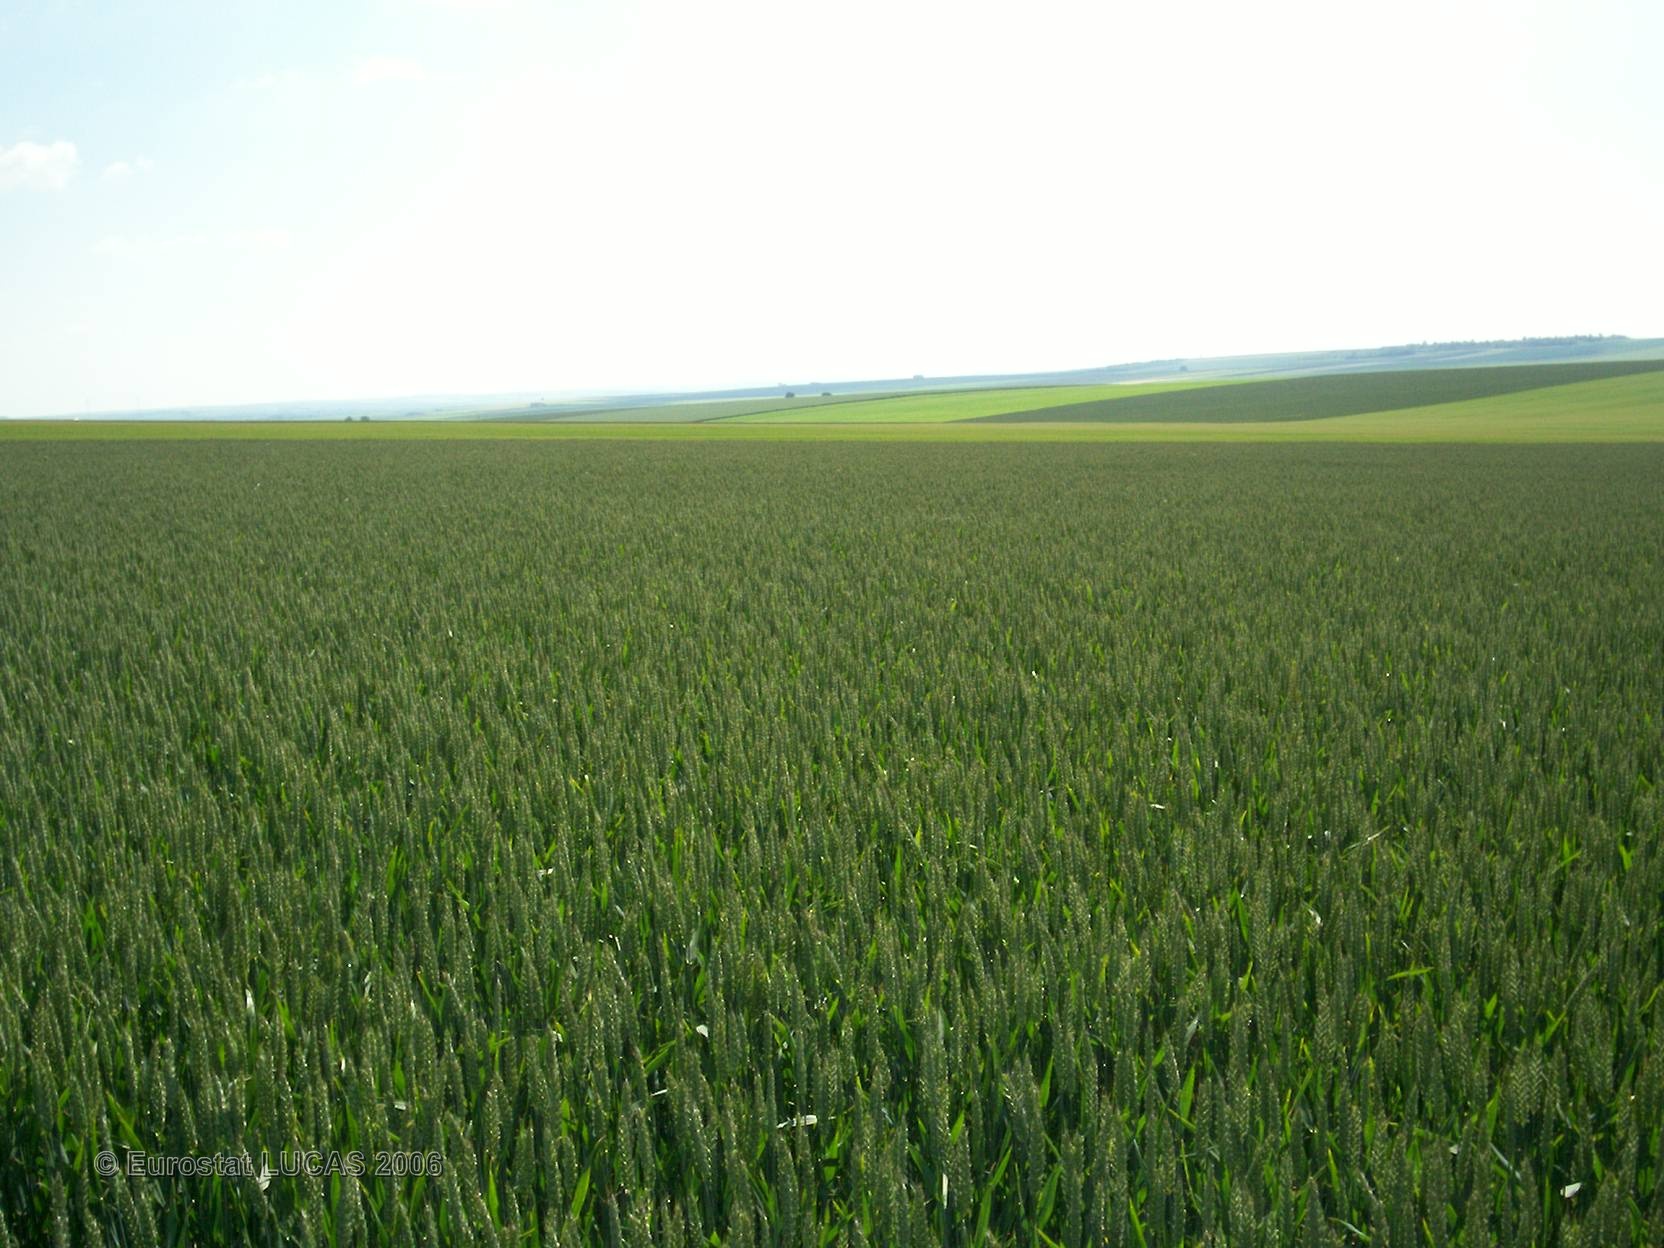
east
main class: Cropland
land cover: Common wheat
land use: Agriculture (excluding fallow land and kitchen gardens)
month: June
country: FR
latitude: 48.8206
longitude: 4.3988
